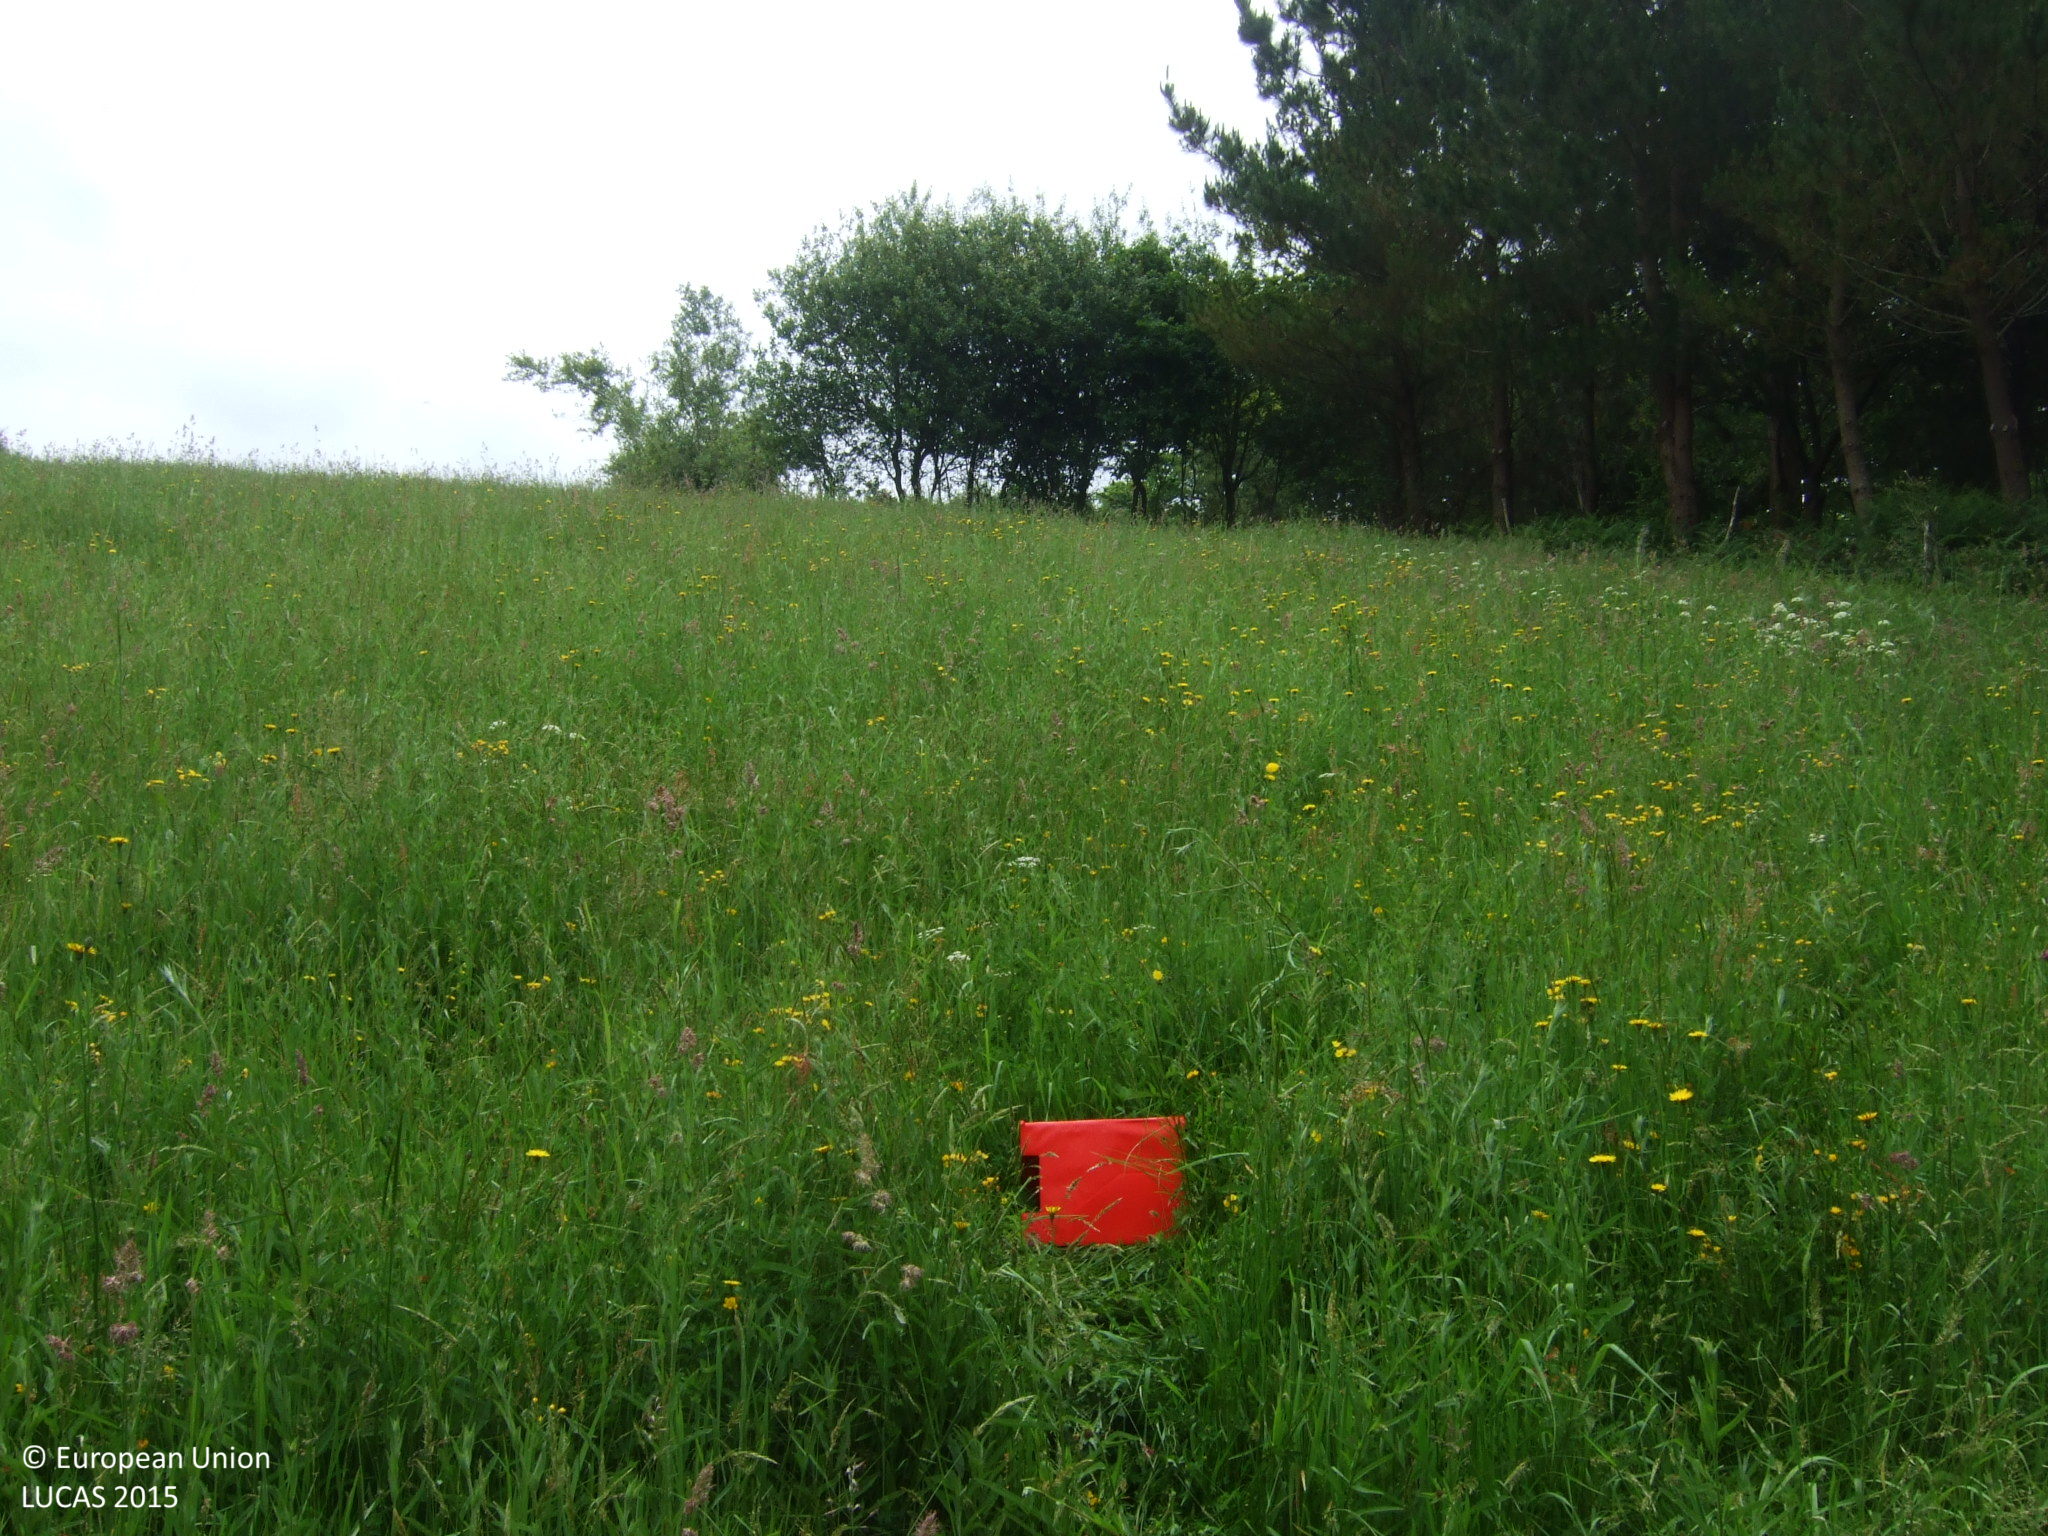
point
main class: Grassland
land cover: Grassland without tree/shrub cover
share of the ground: > 75 %
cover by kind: herbaceous plants 100 %
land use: Agriculture (excluding fallow land and kitchen gardens)
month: June
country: ES
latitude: 43.5558
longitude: -7.7797
